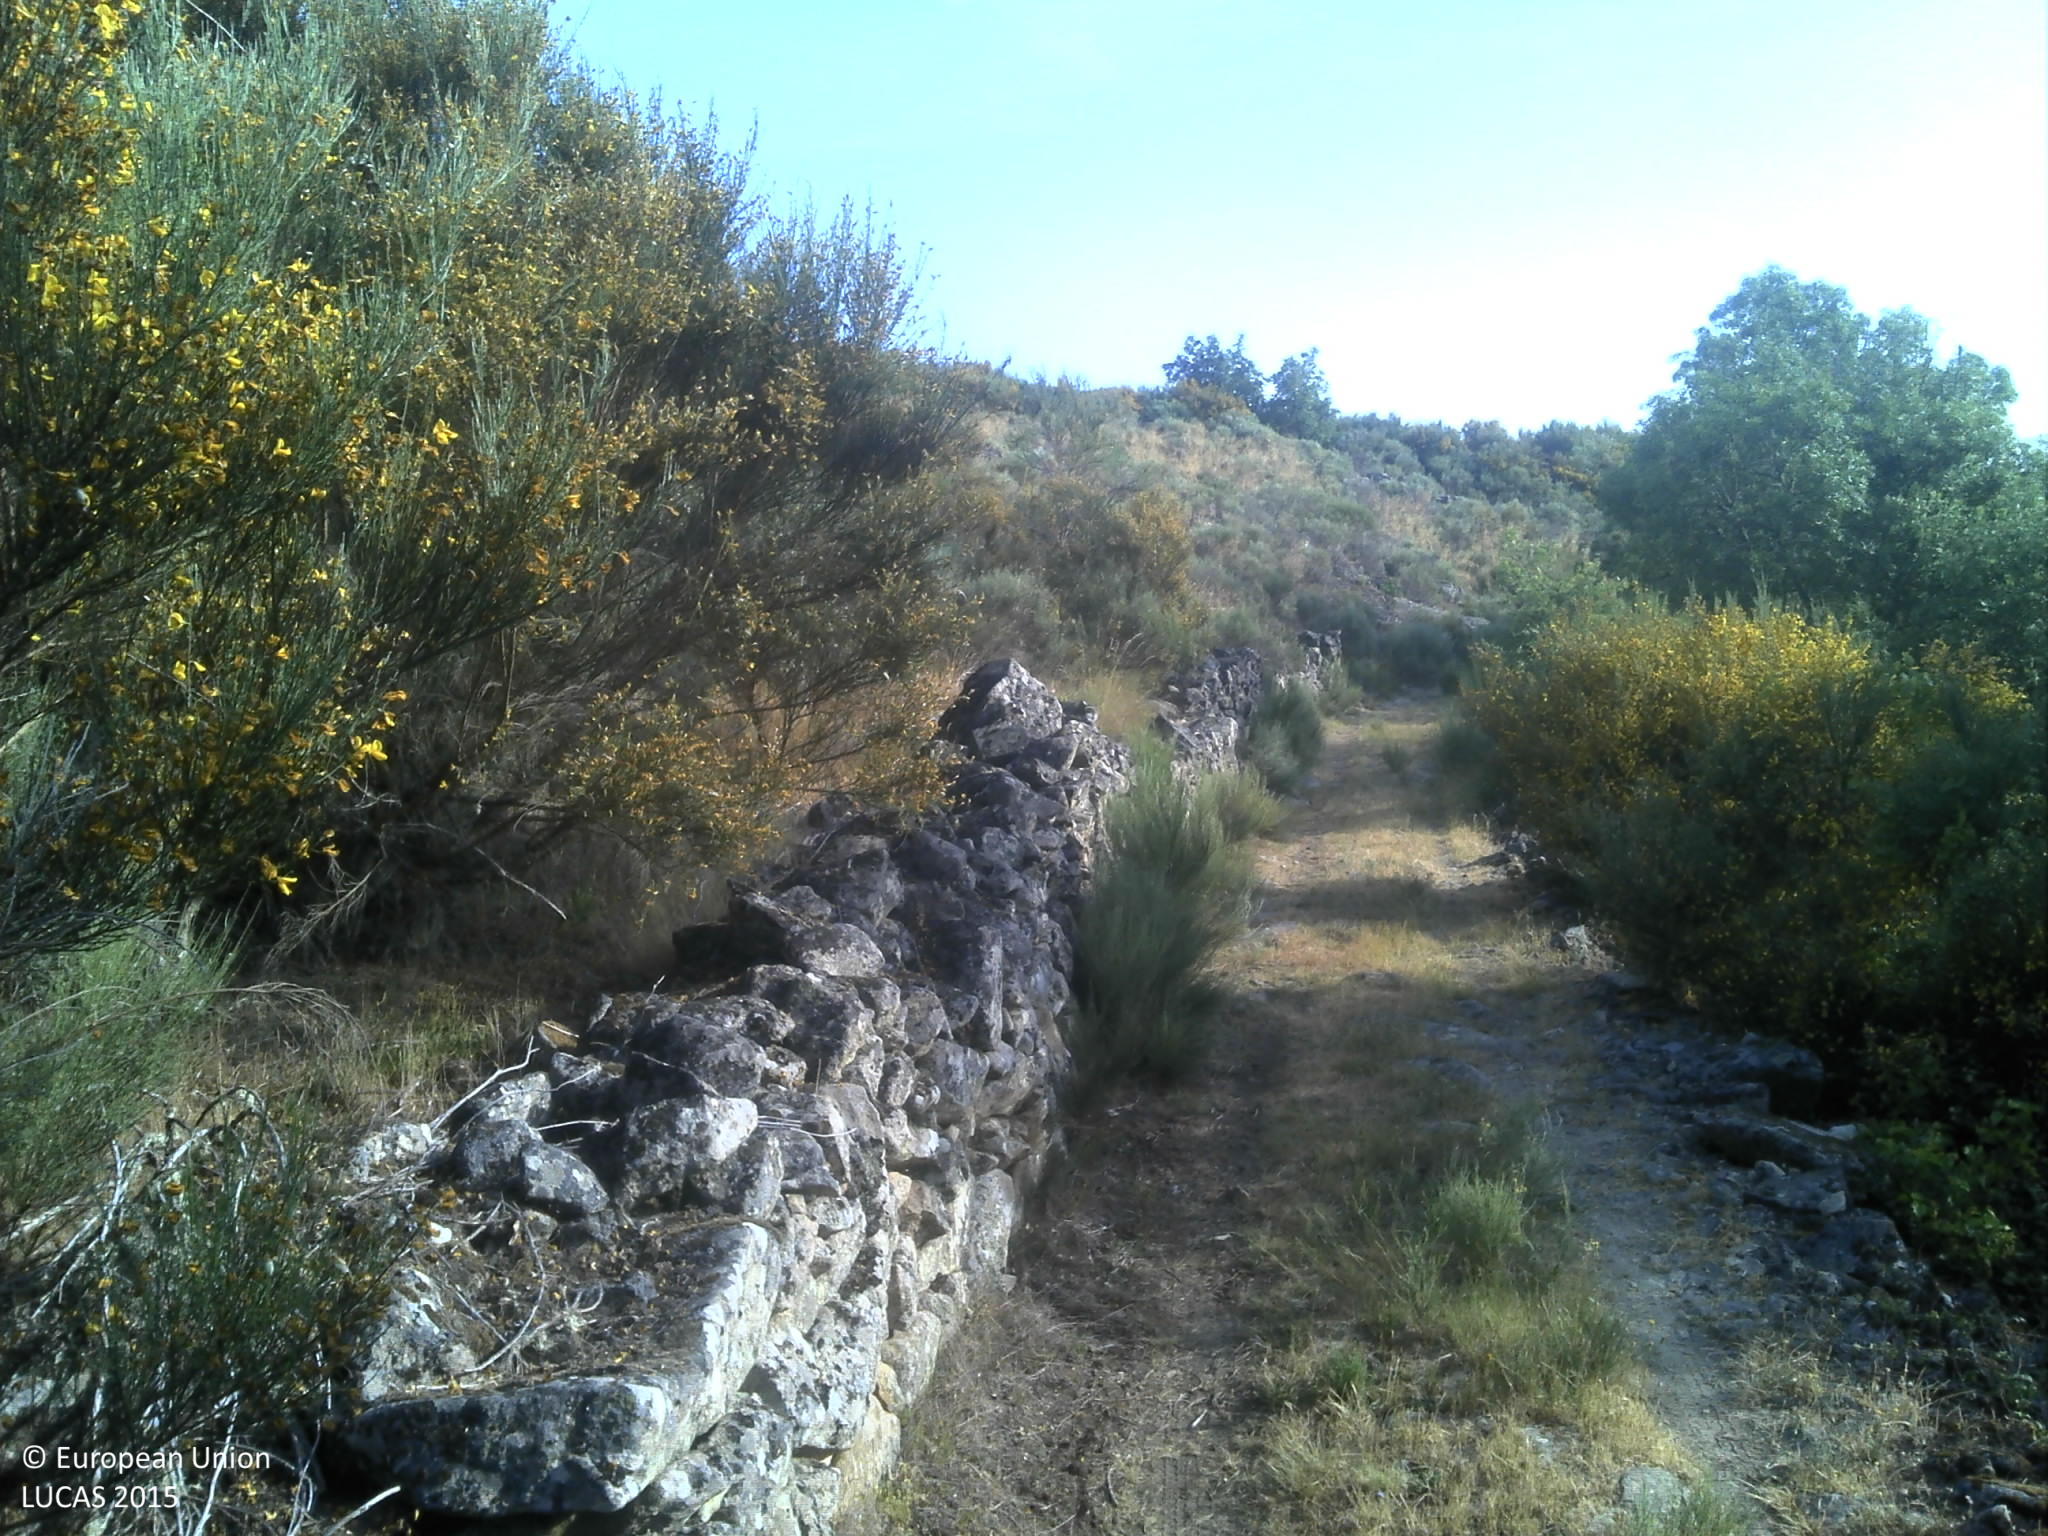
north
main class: Shrubland
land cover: Shrubland without tree cover
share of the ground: 50 - 75 %
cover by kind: shrubs 75 %, unconsolidated bare surface 10 %, herbaceous plants 5 %
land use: Abandoned areas
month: June
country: PT
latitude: 40.3717
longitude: -7.0213
